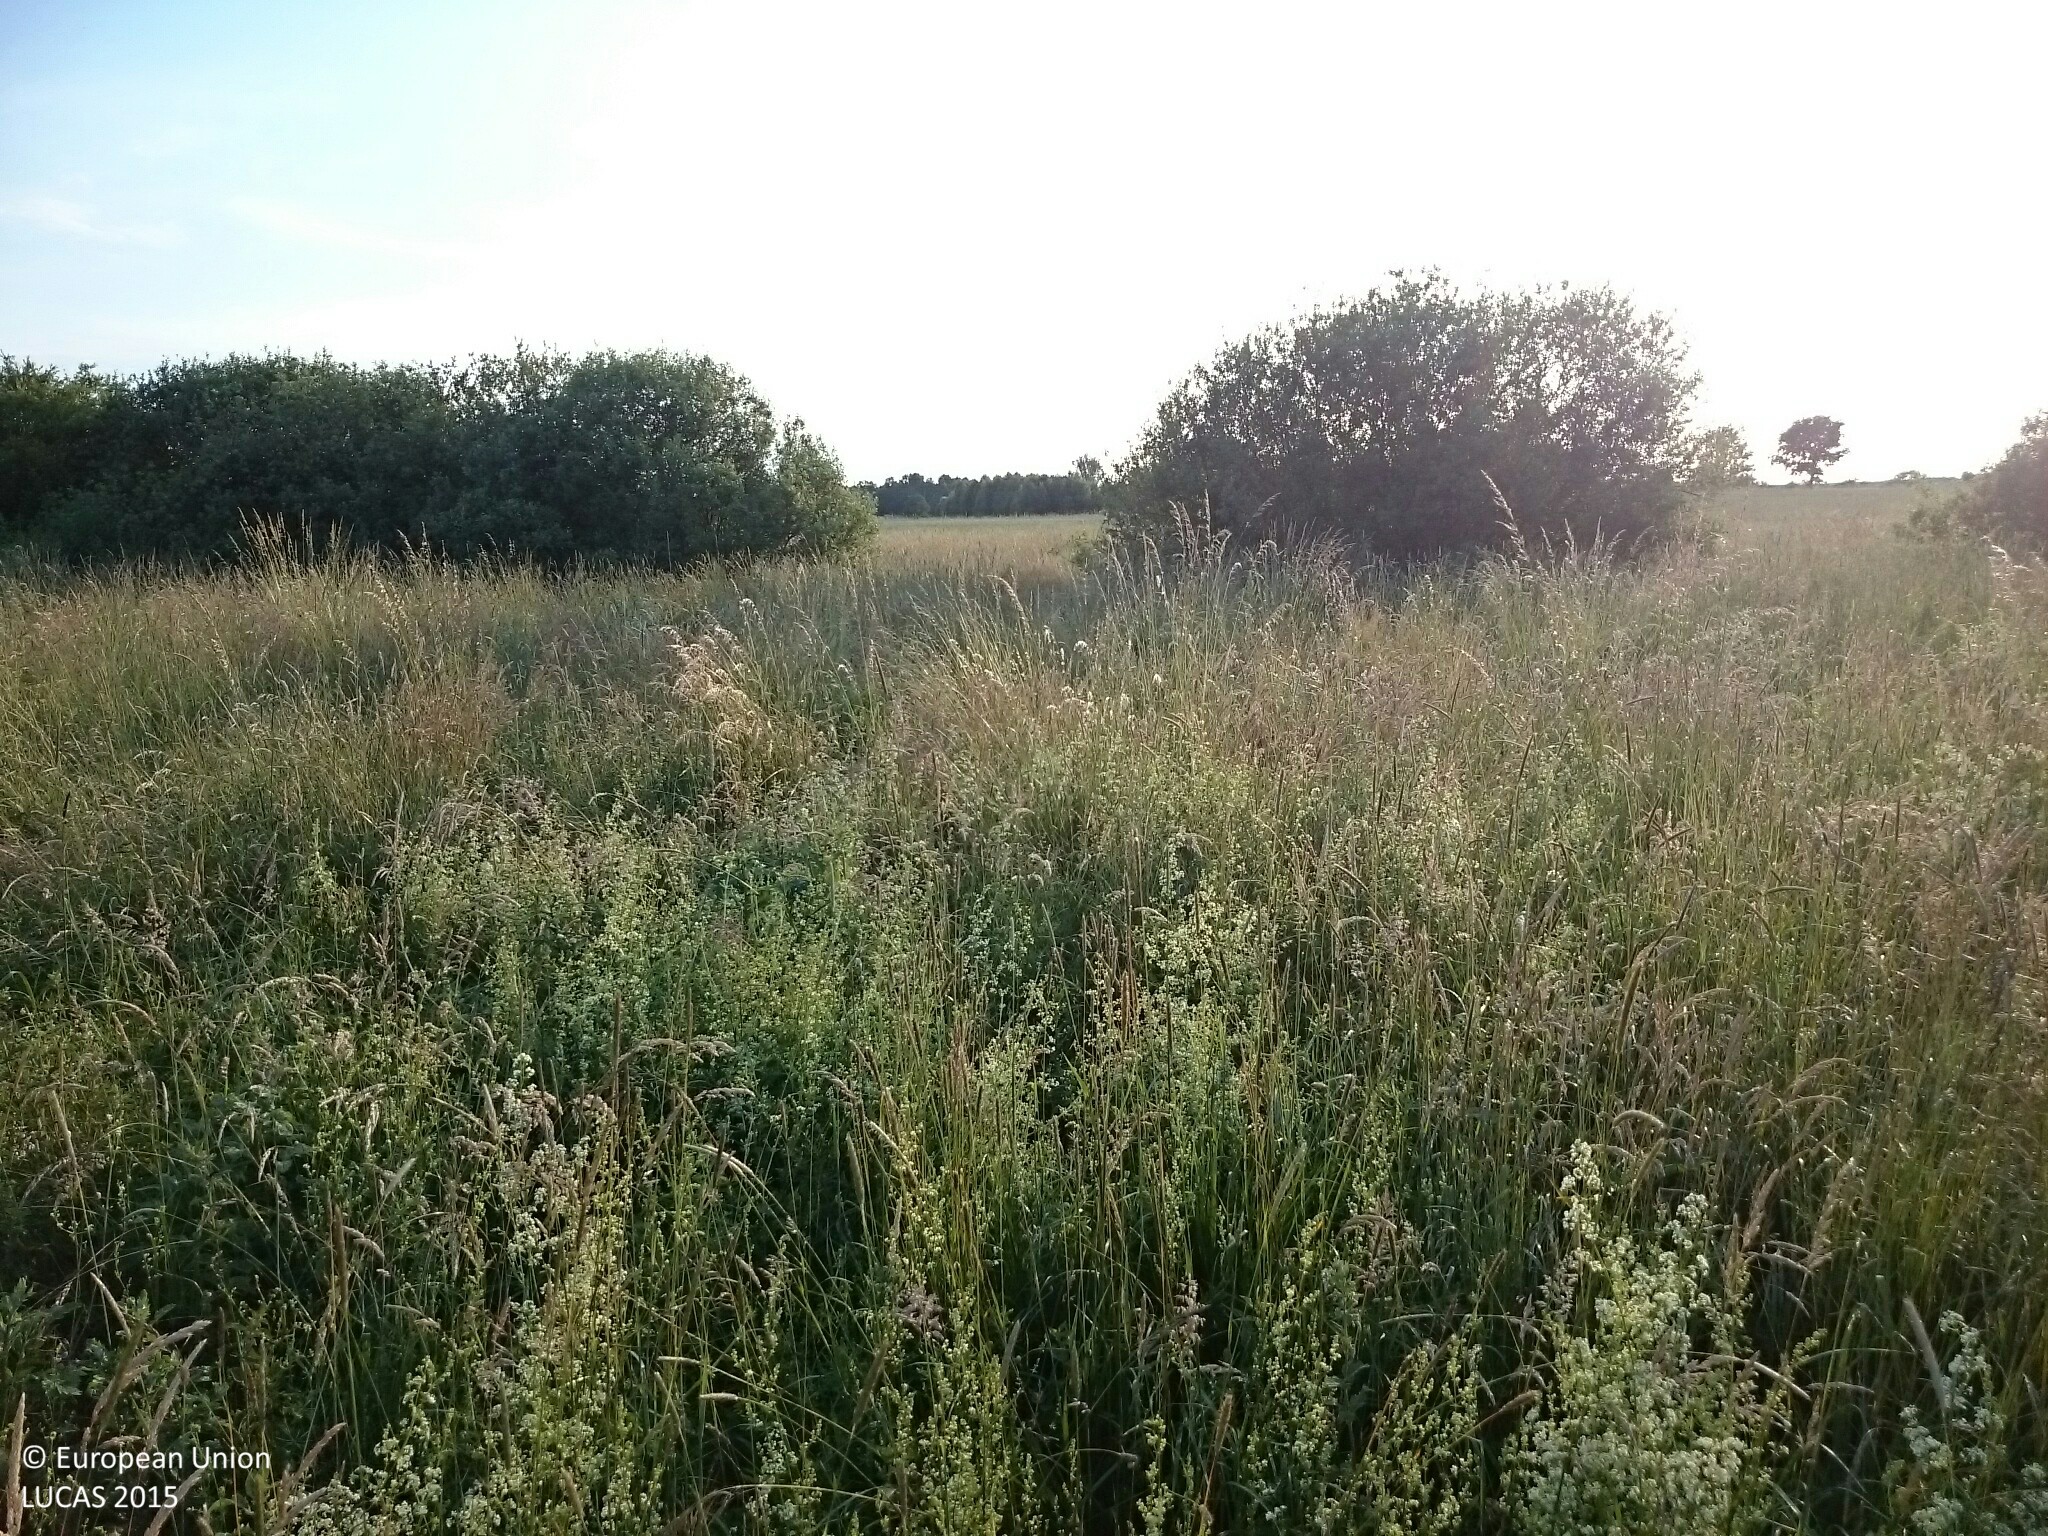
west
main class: Grassland
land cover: Spontaneously vegetated surfaces
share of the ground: > 75 %
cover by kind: herbaceous plants 100 %
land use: Semi-natural and natural areas not in use
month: June
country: PL
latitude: 53.0149
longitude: 15.7132
